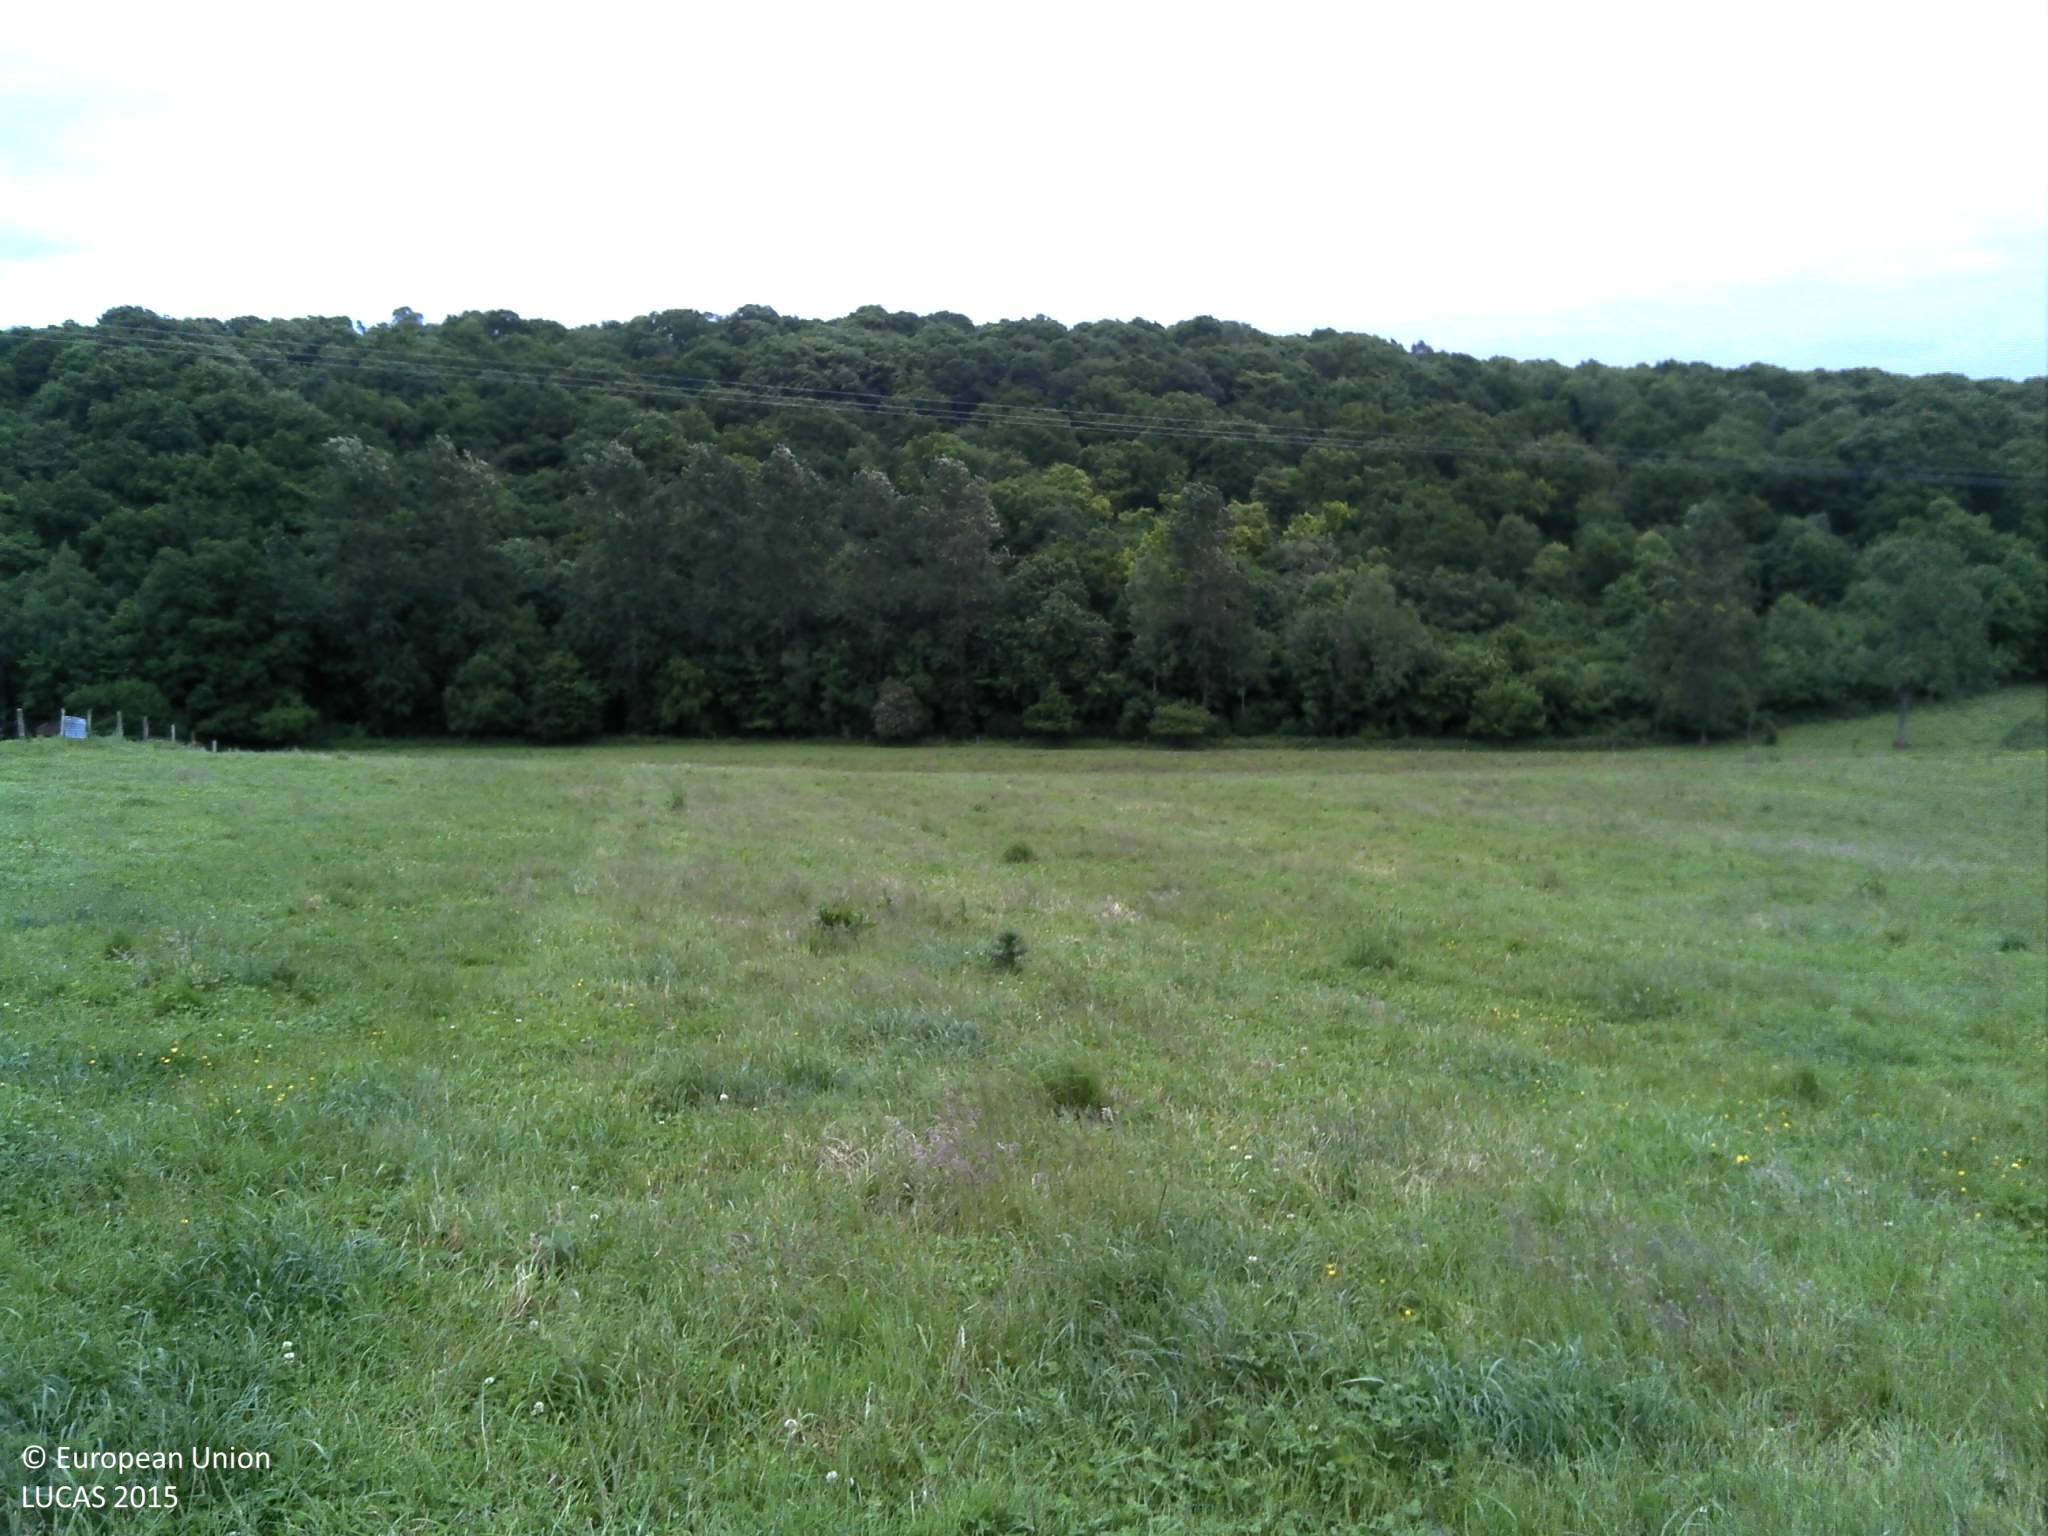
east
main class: Grassland
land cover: Grassland without tree/shrub cover
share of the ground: > 75 %
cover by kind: herbaceous plants 100 %
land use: Agriculture (excluding fallow land and kitchen gardens)
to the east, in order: Grassland without tree/shrub cover; Fences; Grassland without tree/shrub cover; Fences; Grassland without tree/shrub cover; Fences; Broadleaved woodland
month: June
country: FR
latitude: 49.5545
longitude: 0.9784
